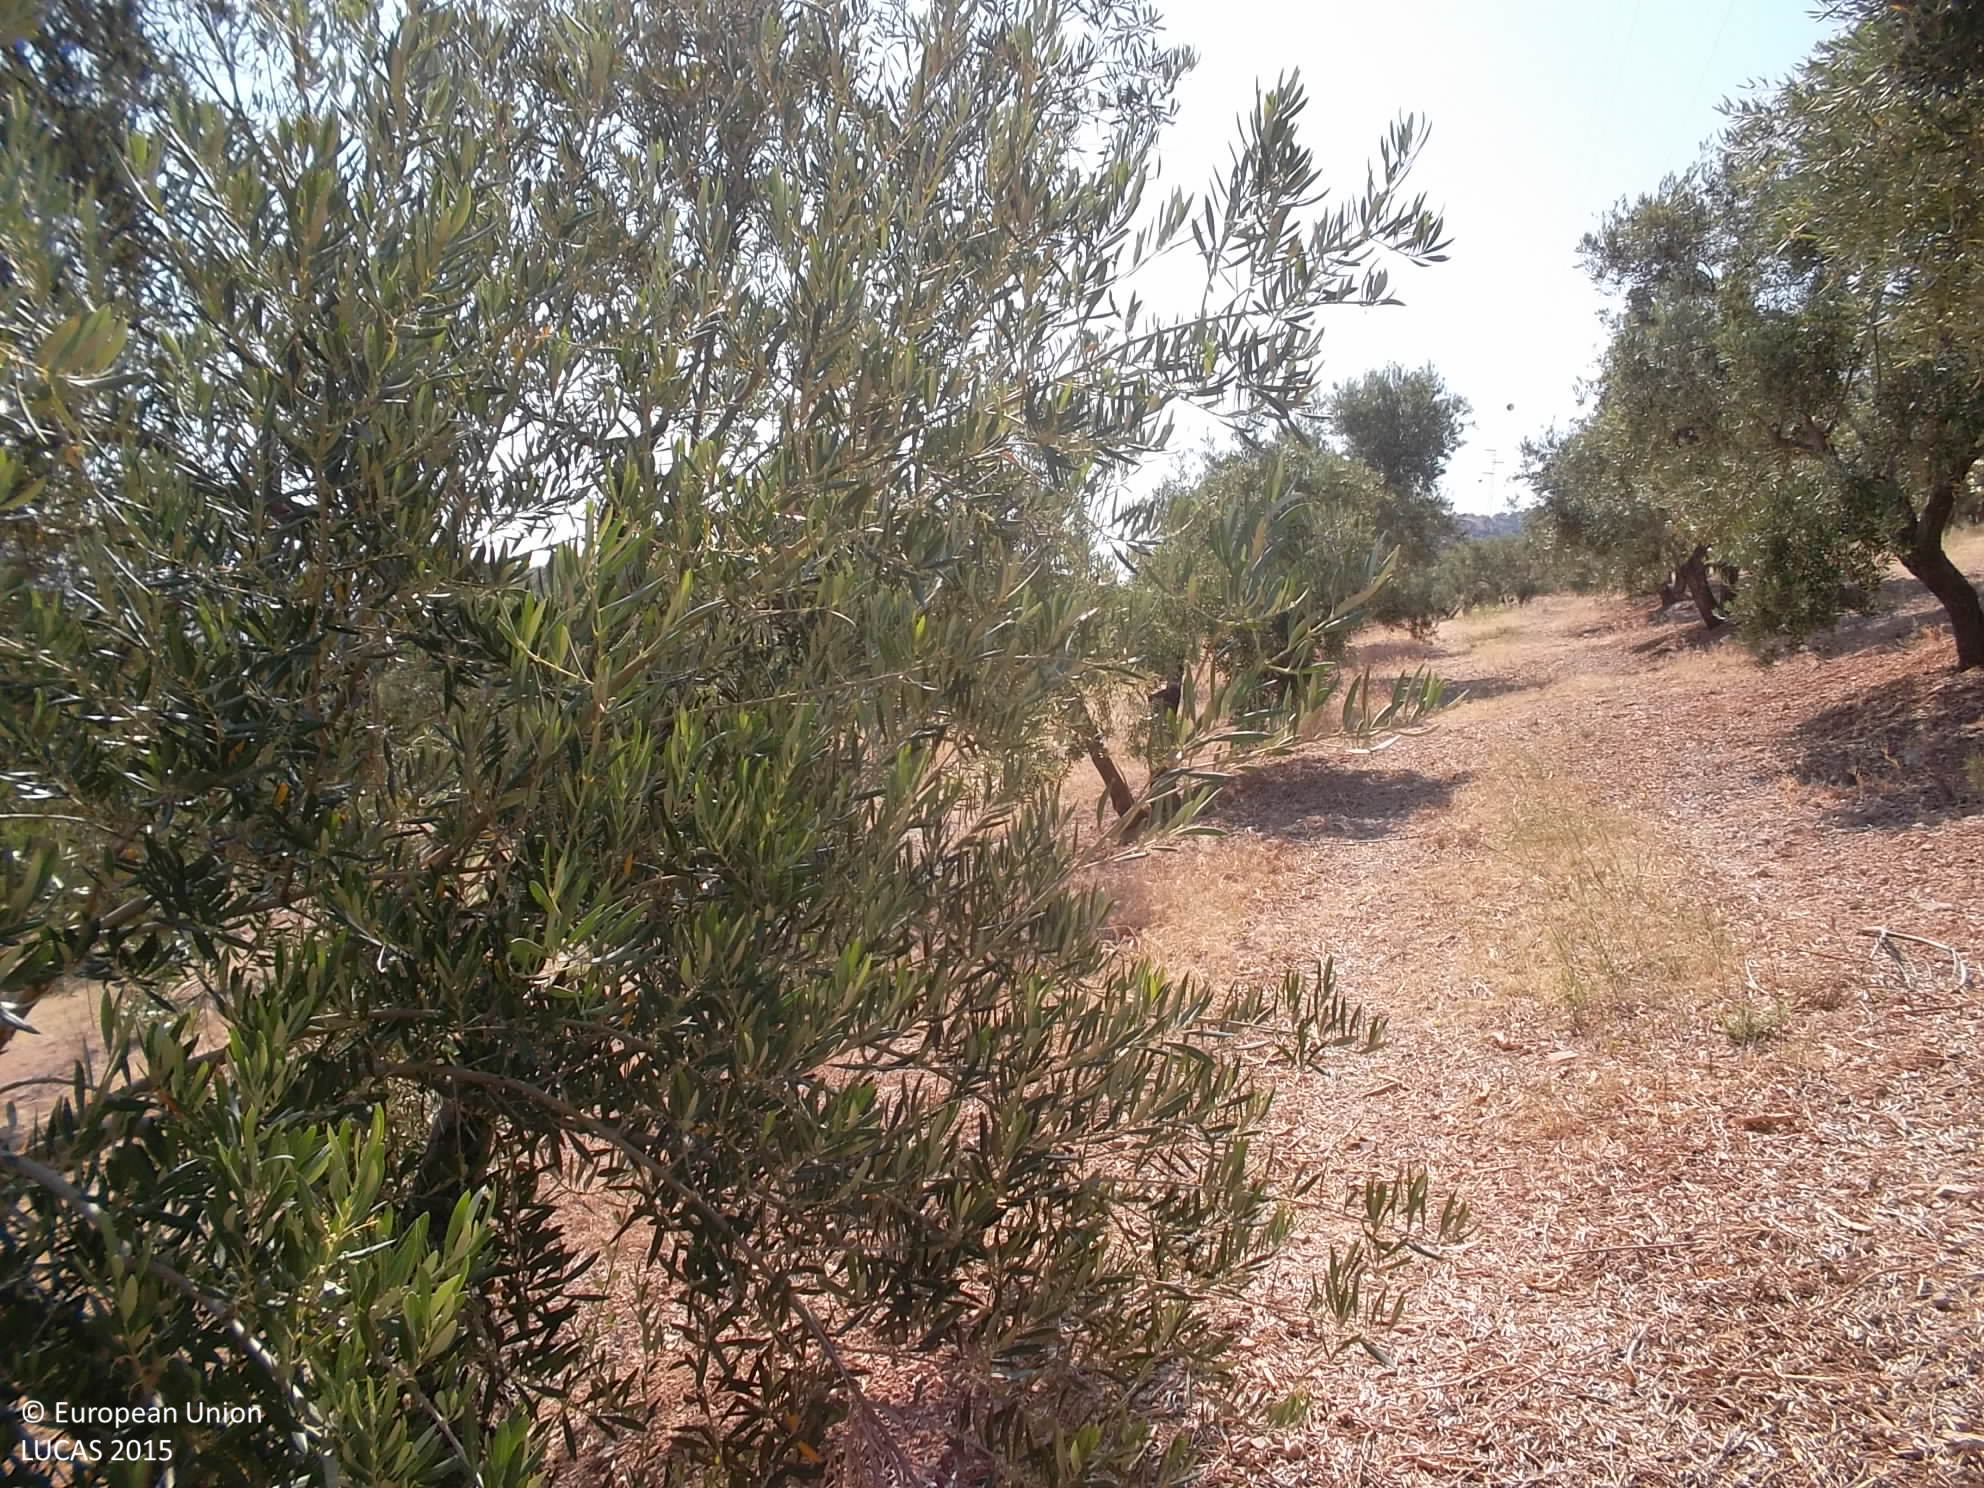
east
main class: Cropland
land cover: Olive groves
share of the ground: 25 - 50 %
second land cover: Spontaneously vegetated surfaces
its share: > 75 %
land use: Agriculture (excluding fallow land and kitchen gardens)
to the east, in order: Olive groves; Spontaneously vegetated surfaces; Tracks; Pine dominated coniferous woodland; Shrubland without tree cover; Tracks
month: June
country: ES
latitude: 37.7257
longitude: -3.3037
